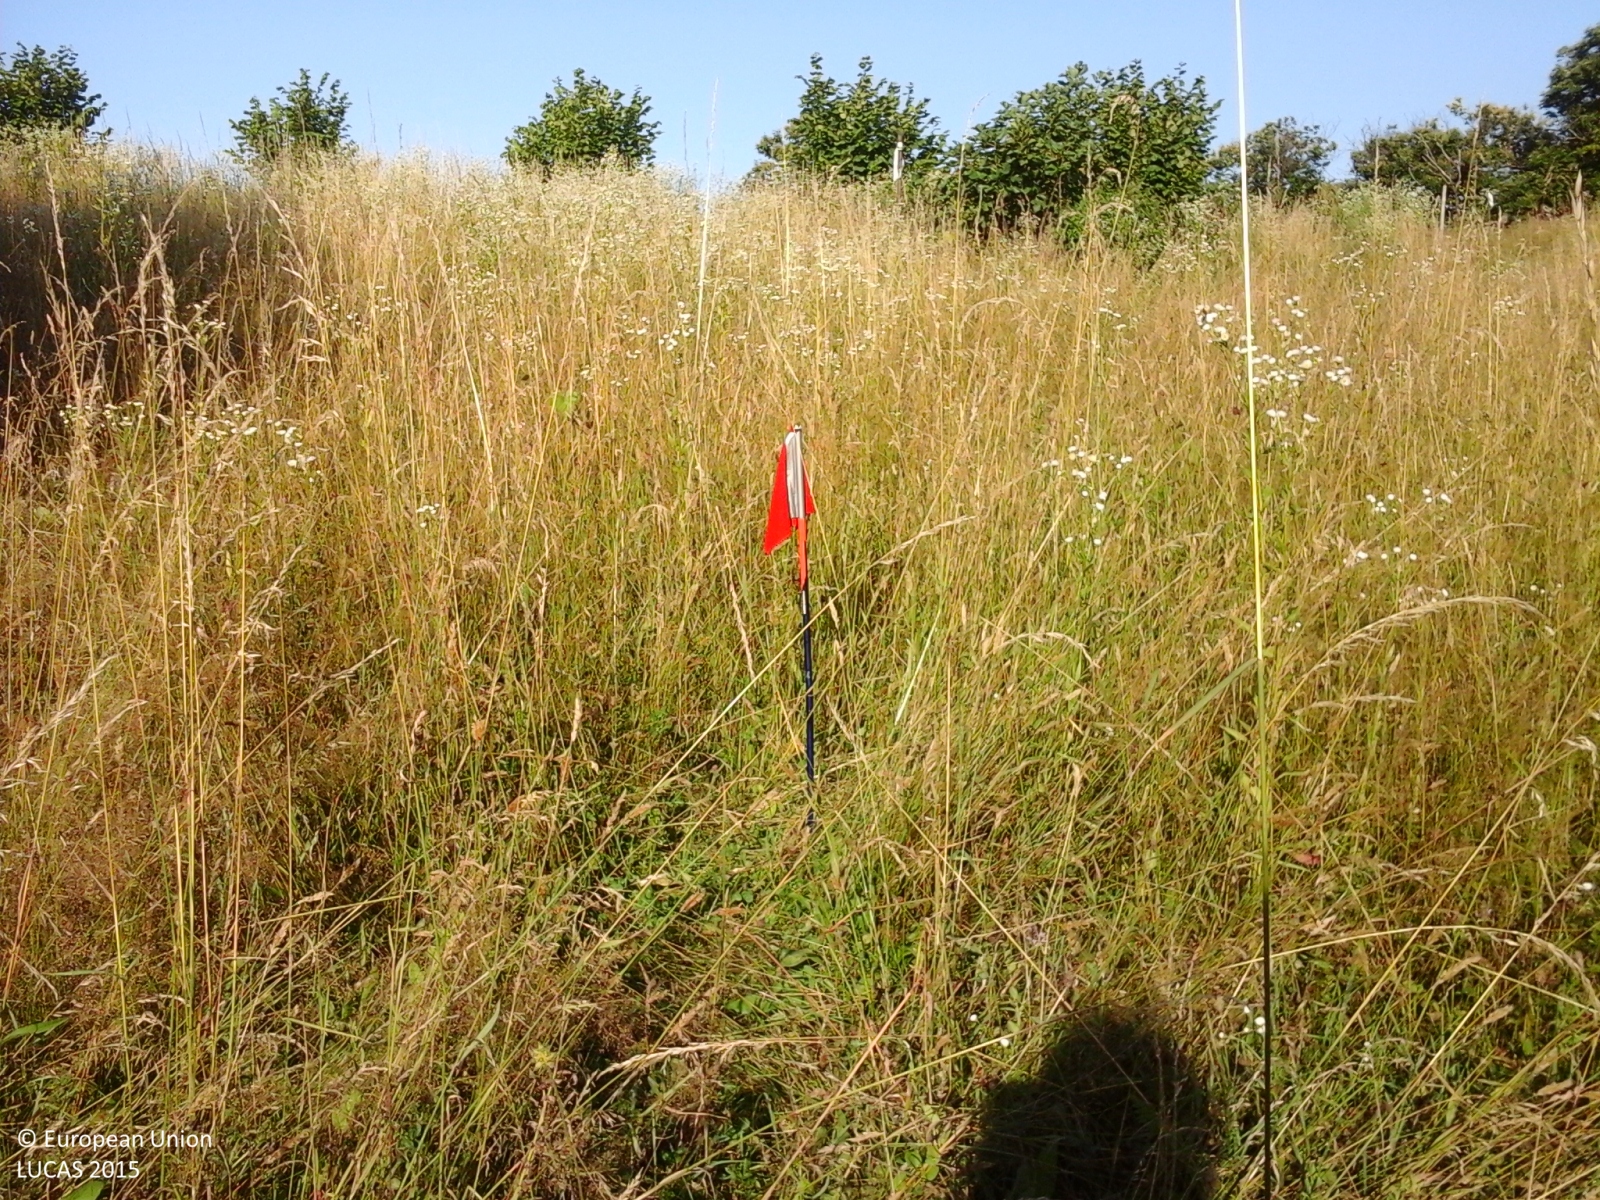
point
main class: Grassland
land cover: Grassland without tree/shrub cover
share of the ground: > 75 %
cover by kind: herbaceous plants 100 %
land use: Agriculture (excluding fallow land and kitchen gardens)
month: June
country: IT
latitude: 44.3460
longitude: 7.8346
